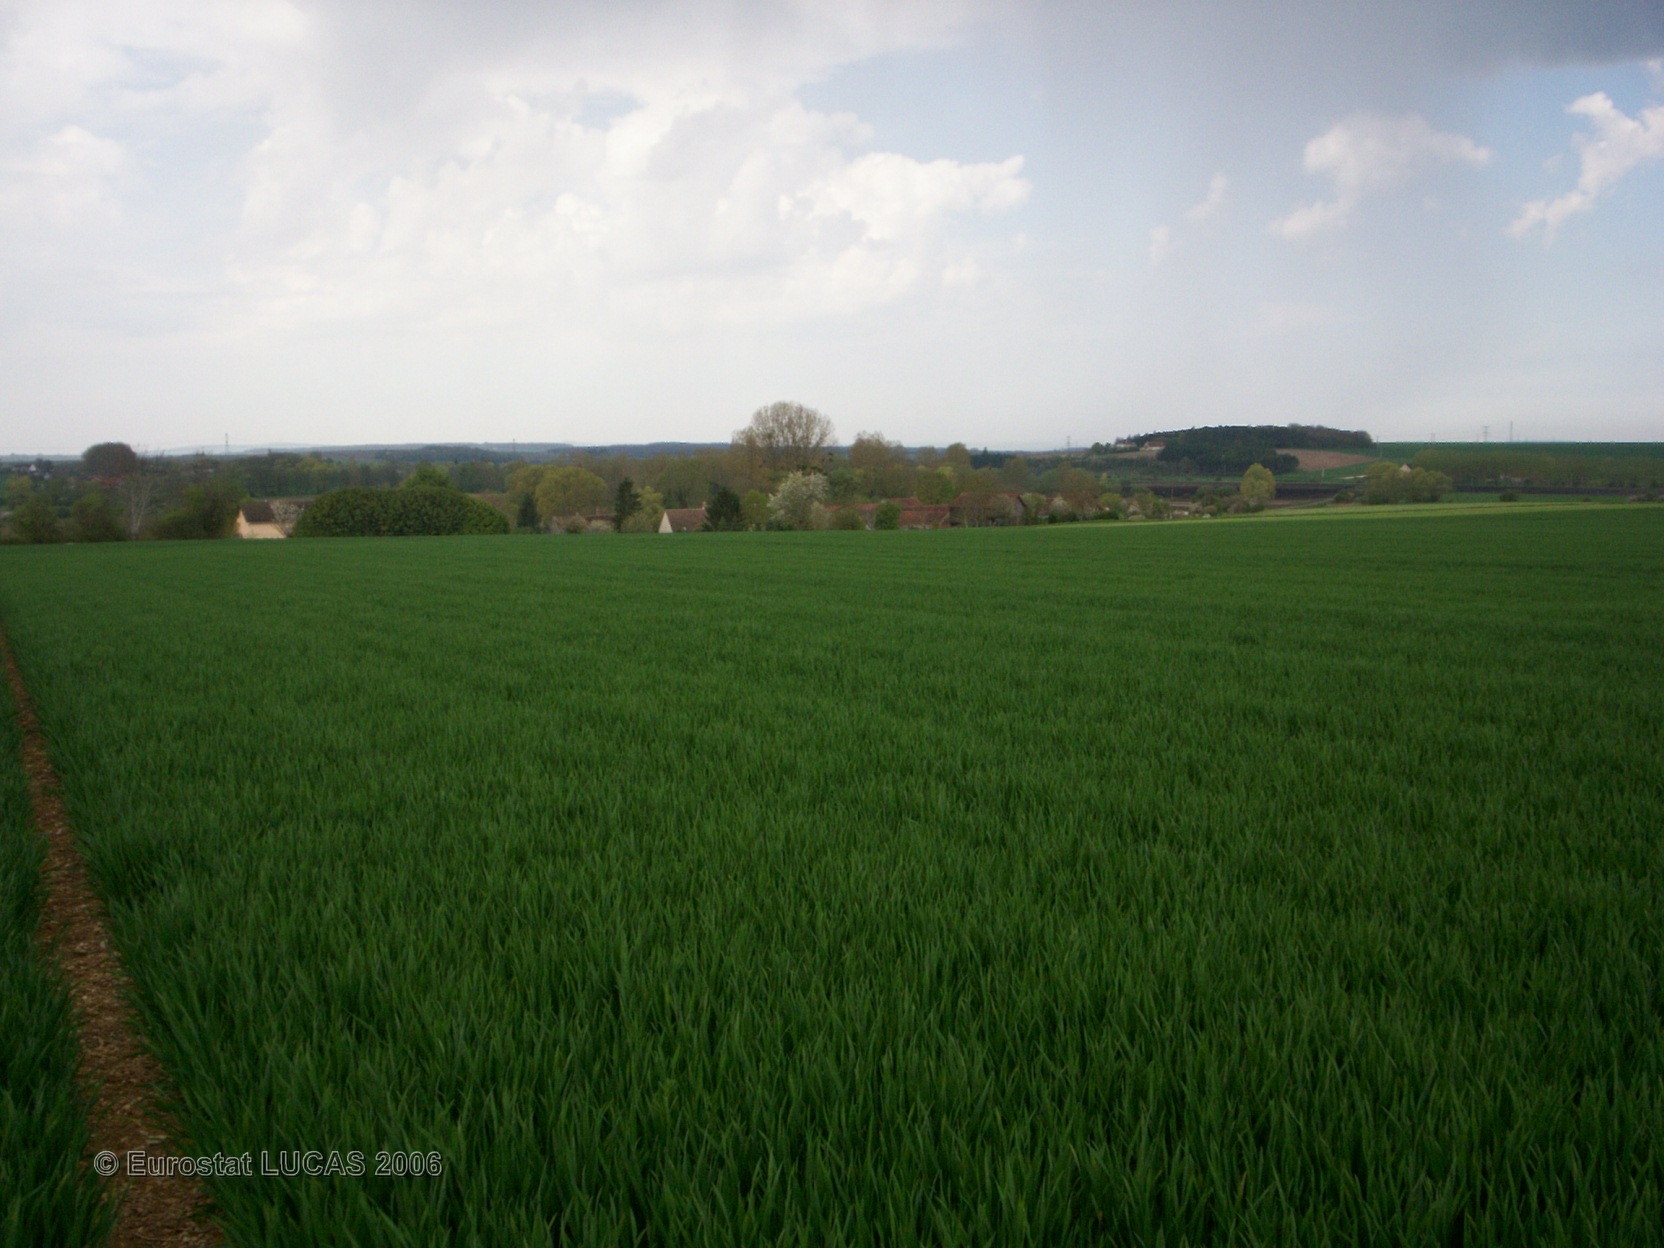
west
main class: Cropland
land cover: Common wheat
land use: Agriculture (excluding fallow land and kitchen gardens)
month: April
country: FR
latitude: 47.3535
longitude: 3.0446
